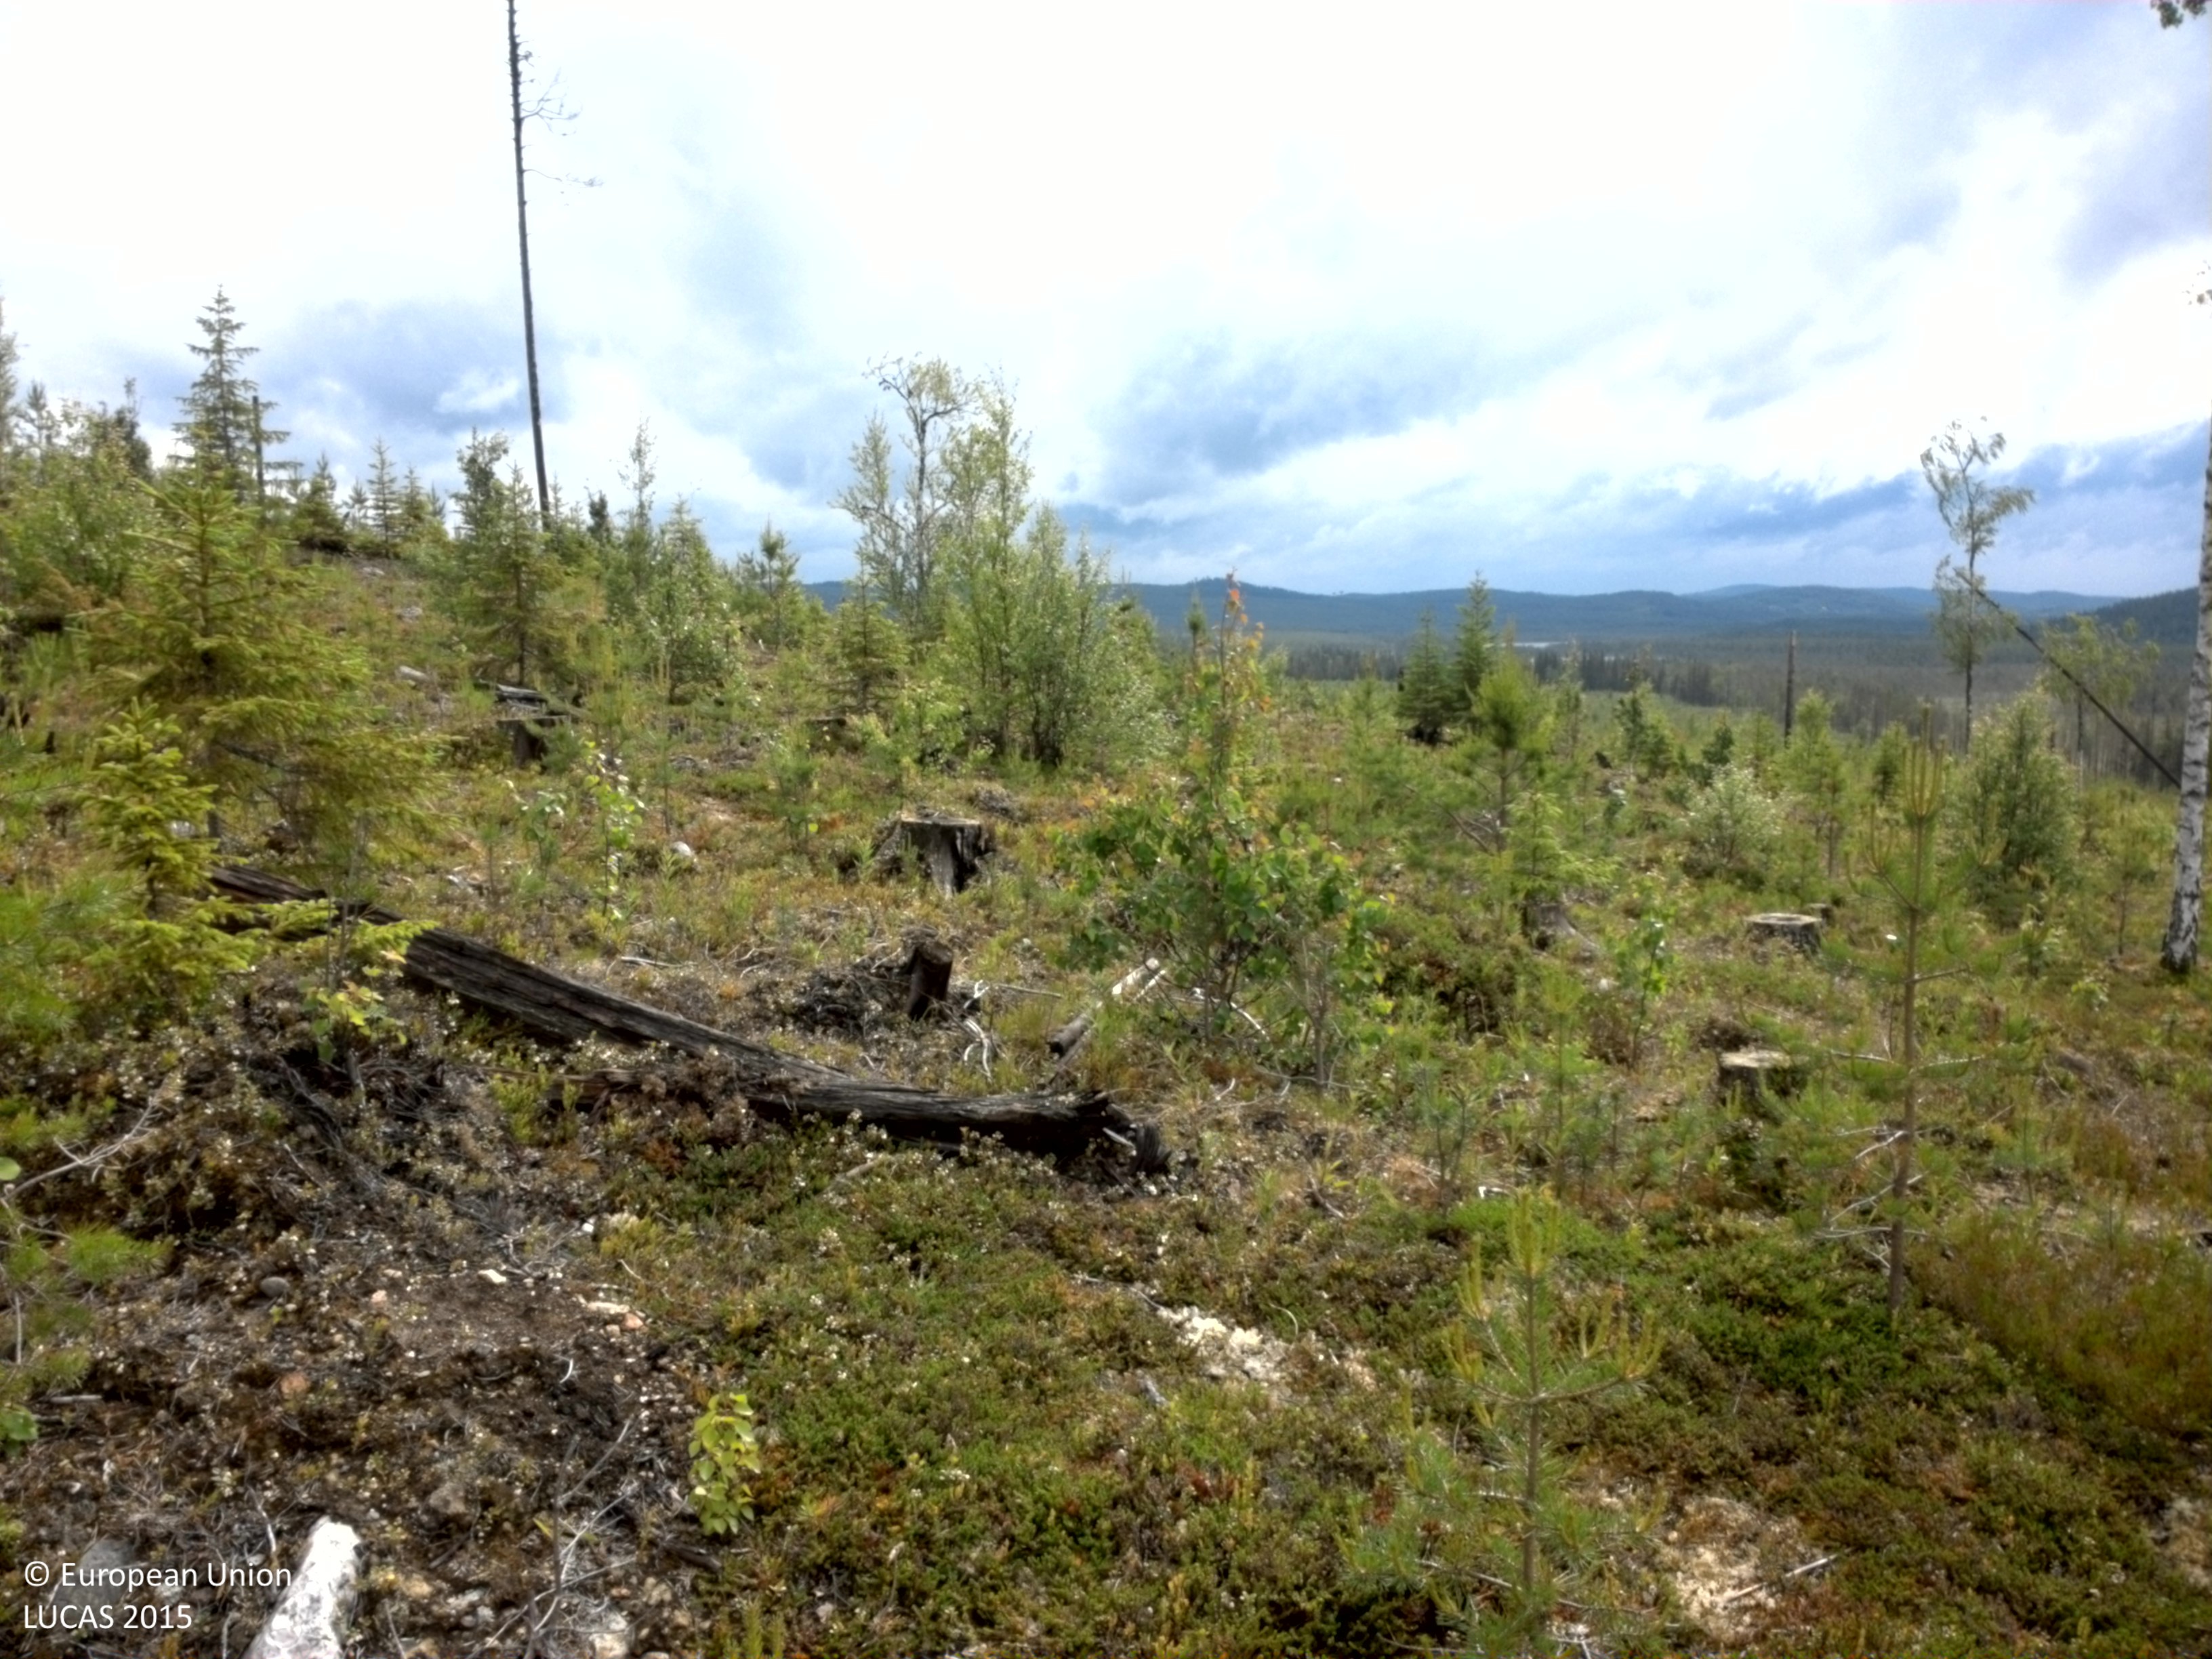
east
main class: Woodland
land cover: Pine dominated mixed woodland
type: boreal forest
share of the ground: 10 - 25 %
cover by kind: shrubs 50 %, lichens and mosses 30 %, coniferous forest trees 15 %, broadleaved forest trees 5 %
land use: Forestry
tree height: < 5 m
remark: Clear cut
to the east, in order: Pine dominated mixed woodland; Pine dominated coniferous woodland; Spruce dominated mixed woodland; Pine dominated coniferous woodland
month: July
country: SE
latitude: 64.6565
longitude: 18.2373
